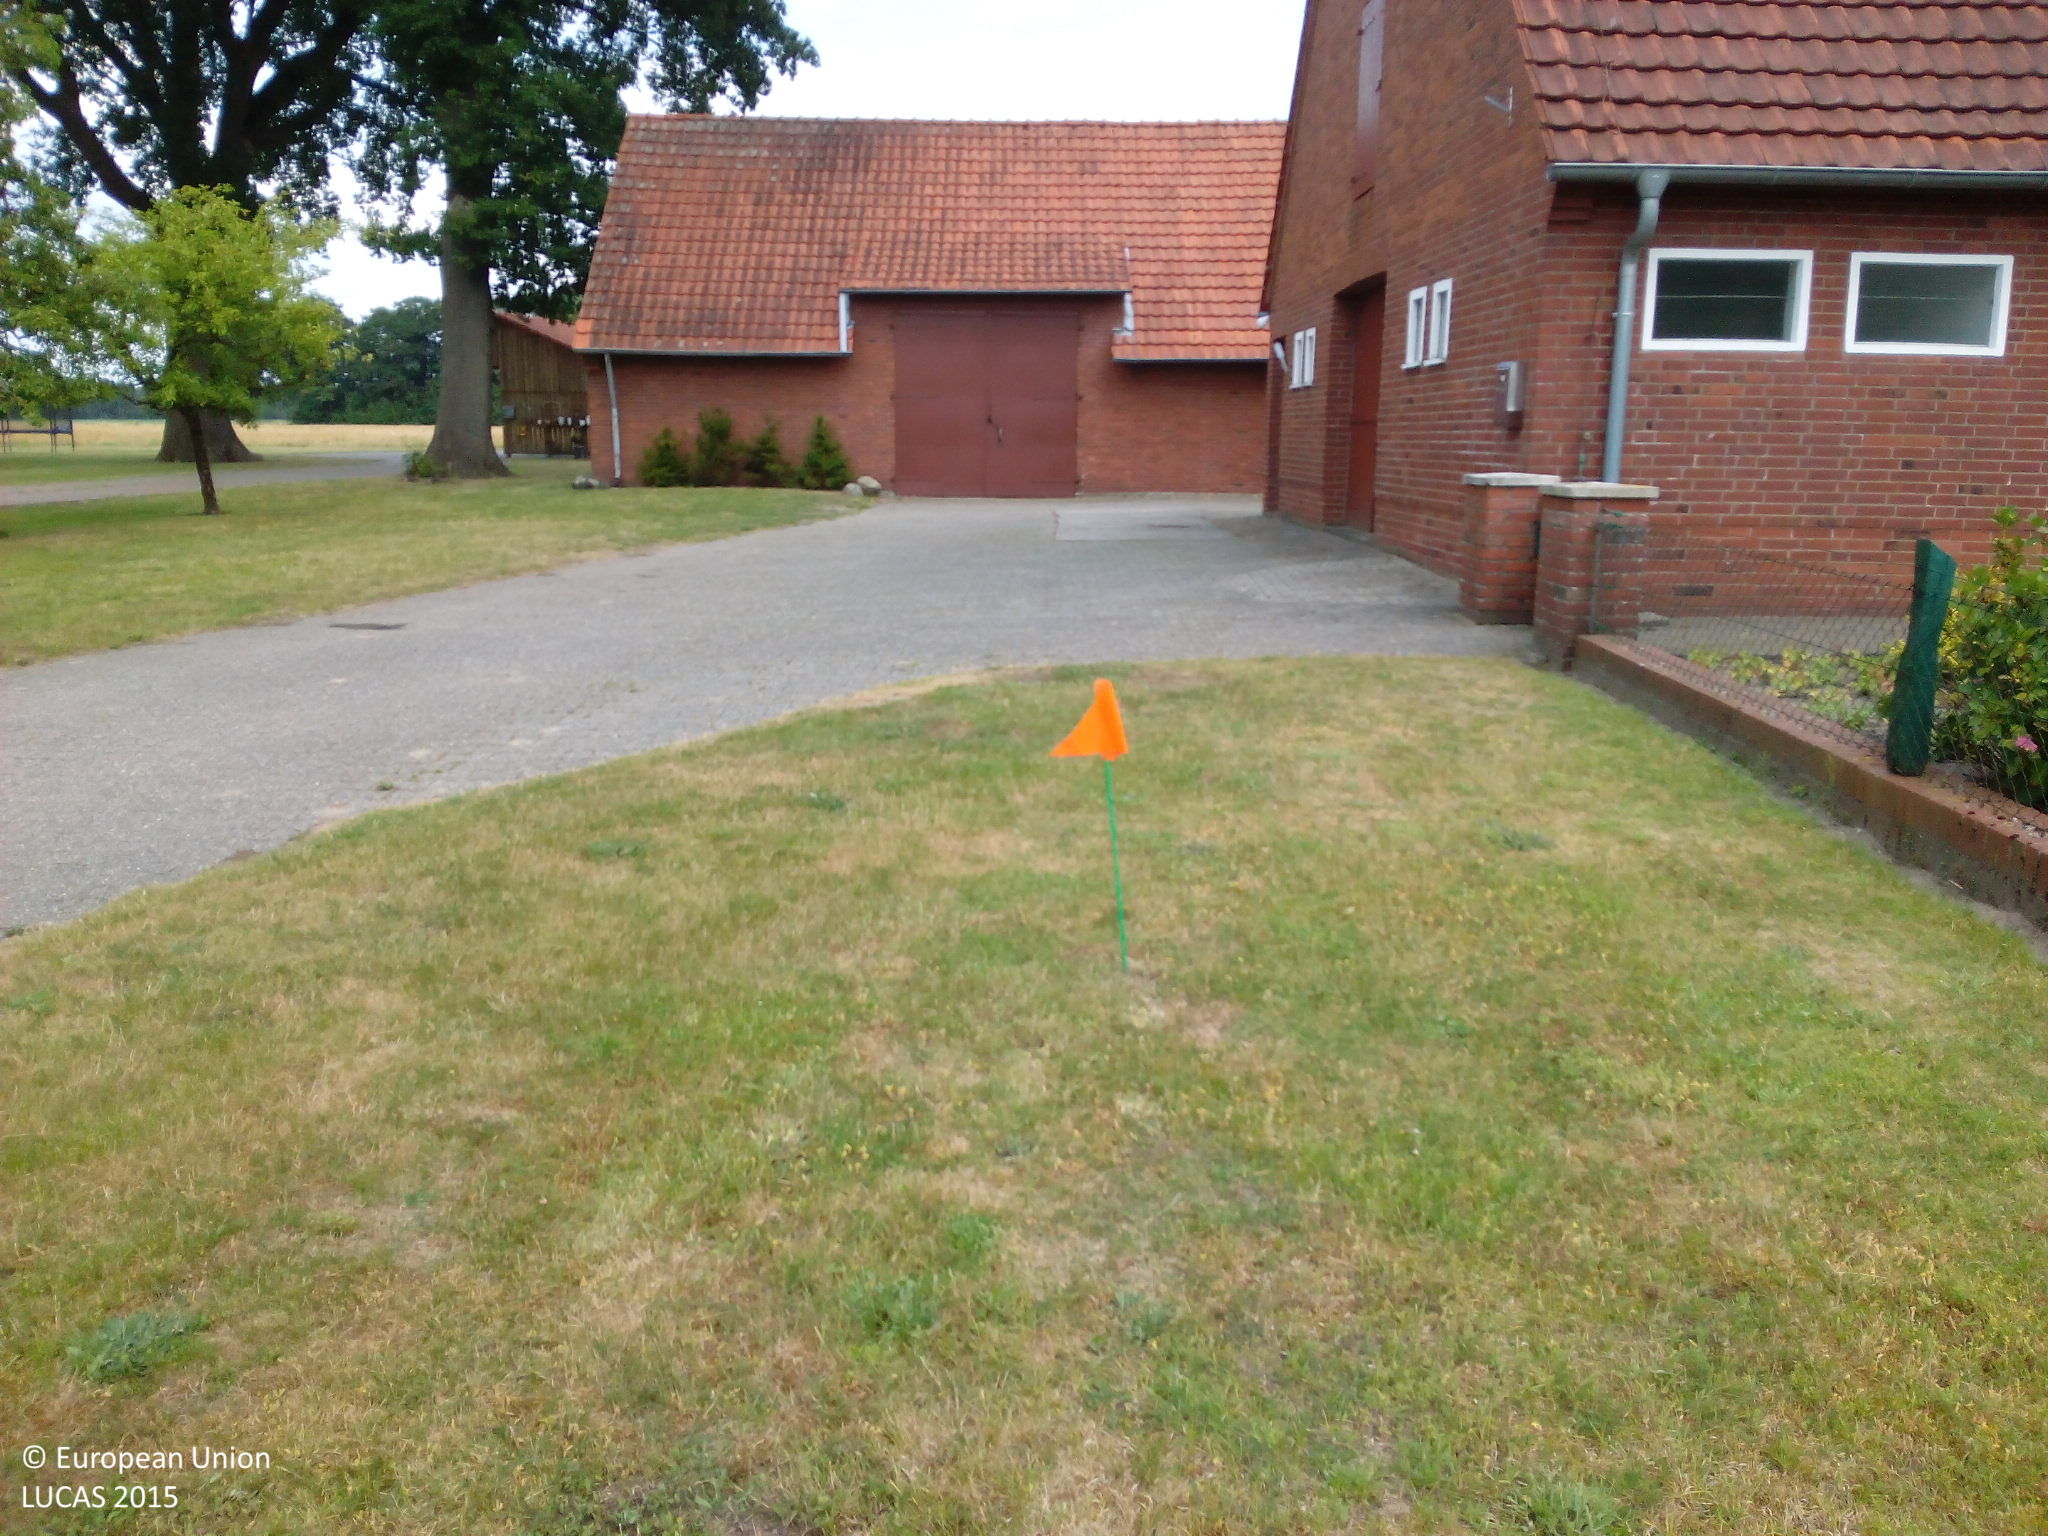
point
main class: Grassland
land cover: Grassland without tree/shrub cover
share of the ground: > 75 %
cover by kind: herbaceous plants 100 %
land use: Residential
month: July
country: DE
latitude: 52.6717
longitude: 7.3532
